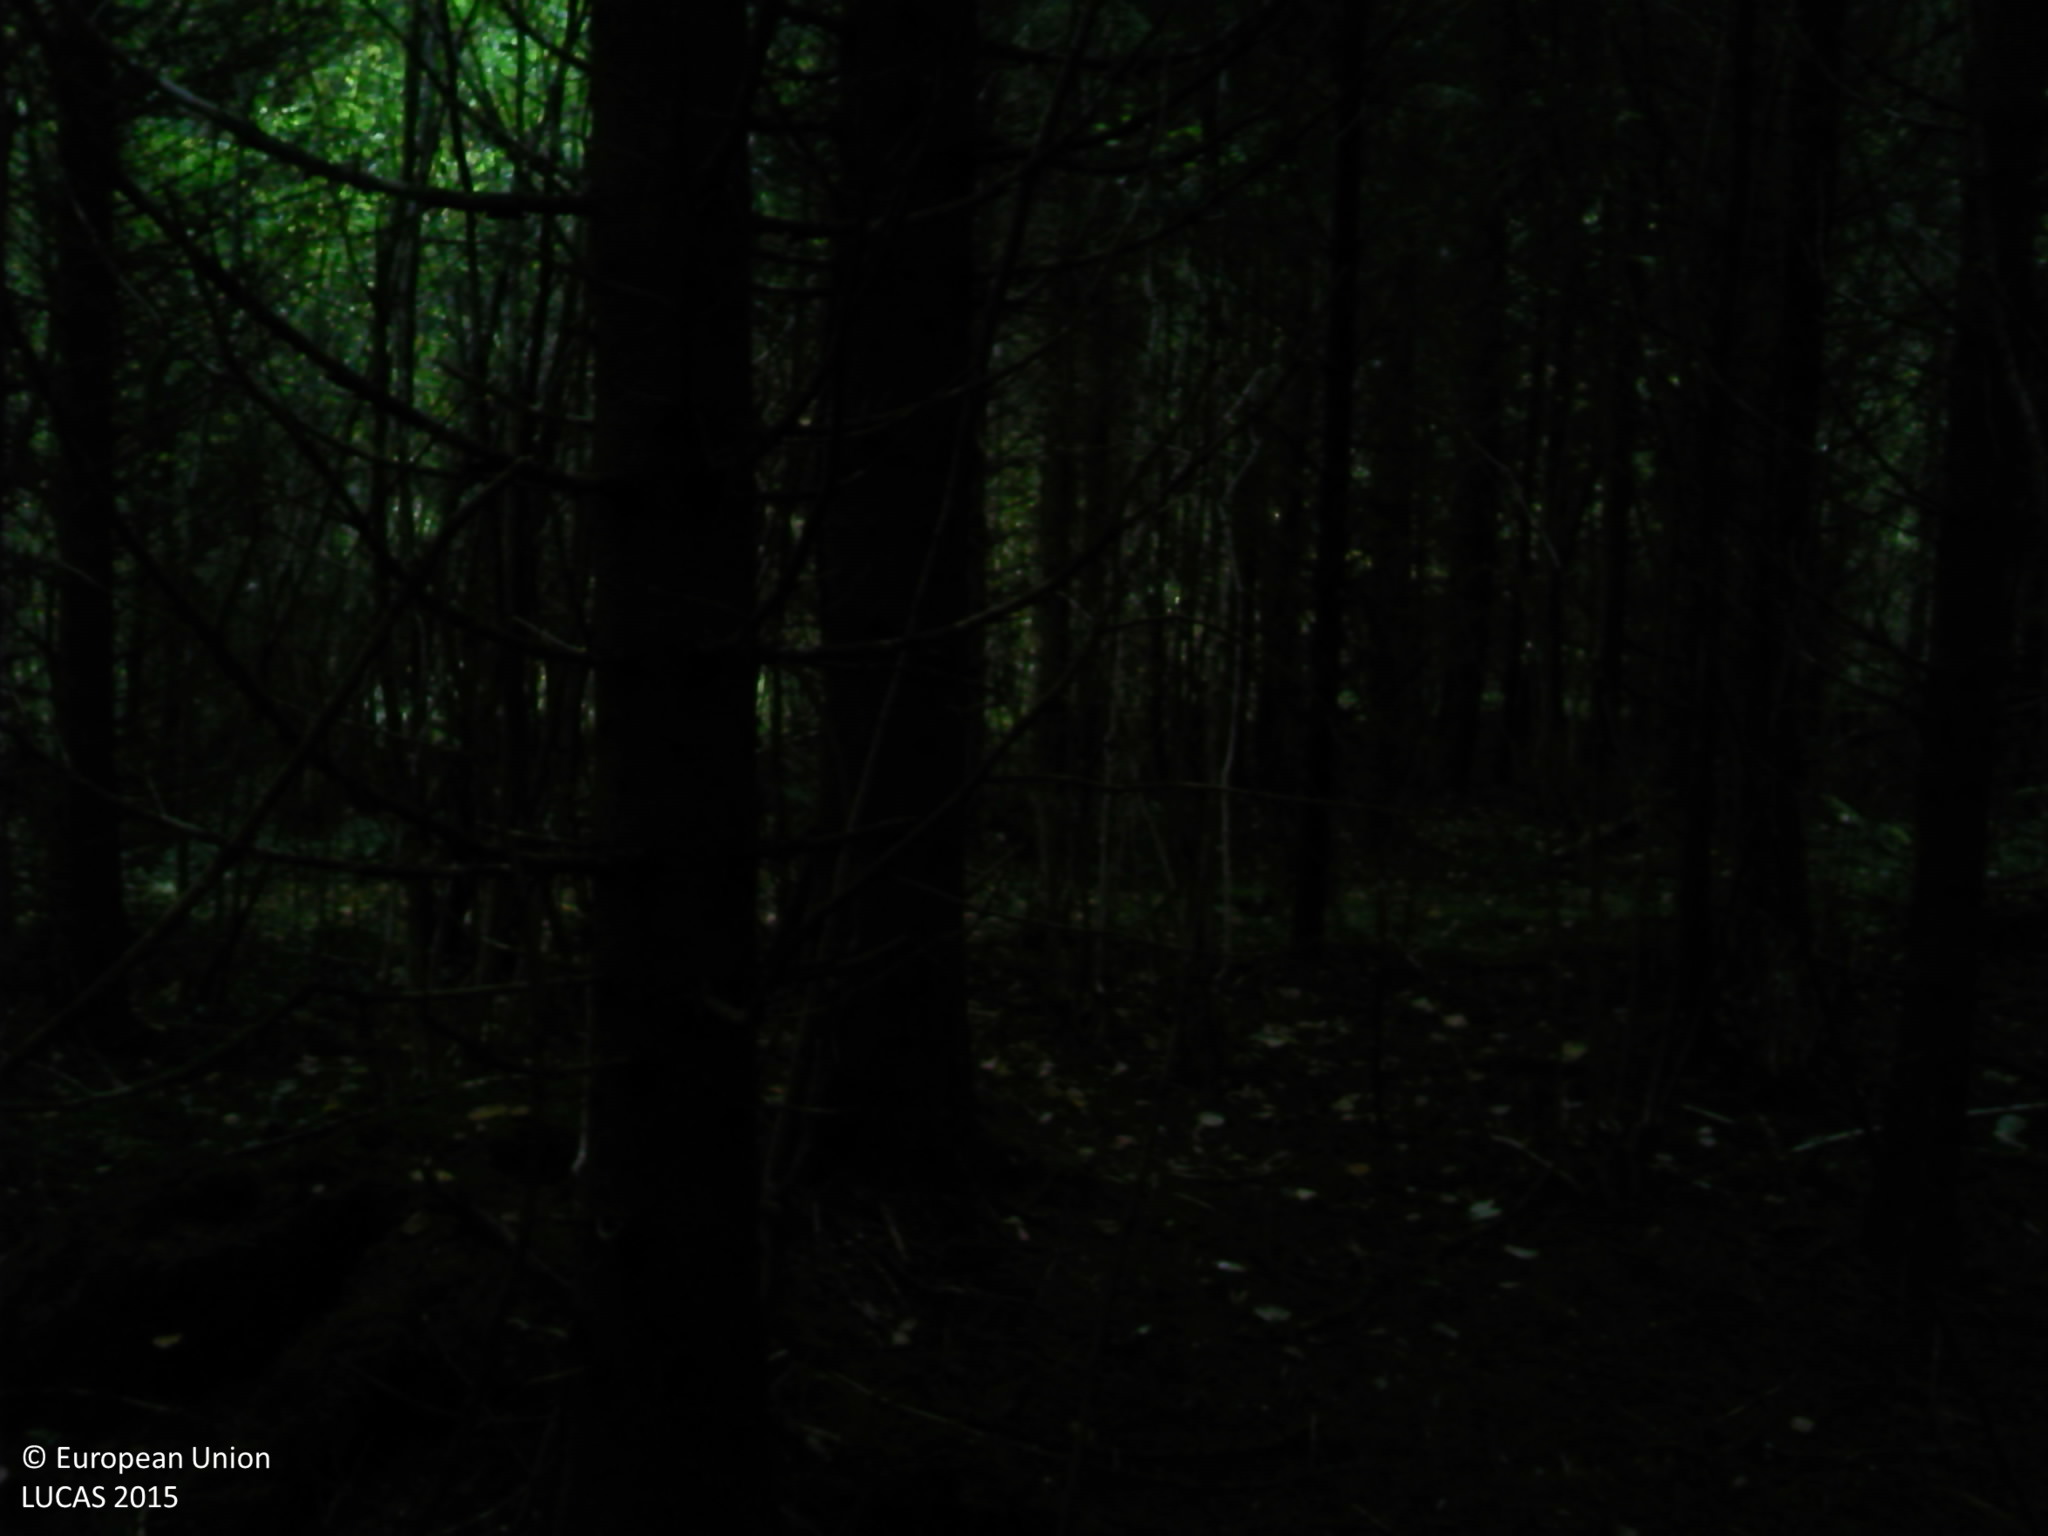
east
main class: Woodland
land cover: Spruce dominated coniferous woodland
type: alpine coniferous forest
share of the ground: > 75 %
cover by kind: coniferous forest trees 100 %
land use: Forestry
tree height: > 5 m
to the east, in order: Spruce dominated coniferous woodland; Tracks; Spruce dominated coniferous woodland; Paved roads, cycling and walking lanes; Spruce dominated coniferous woodland; Tracks; Spruce dominated coniferous woodland
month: October
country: FR
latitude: 46.9463
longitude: 6.0740
